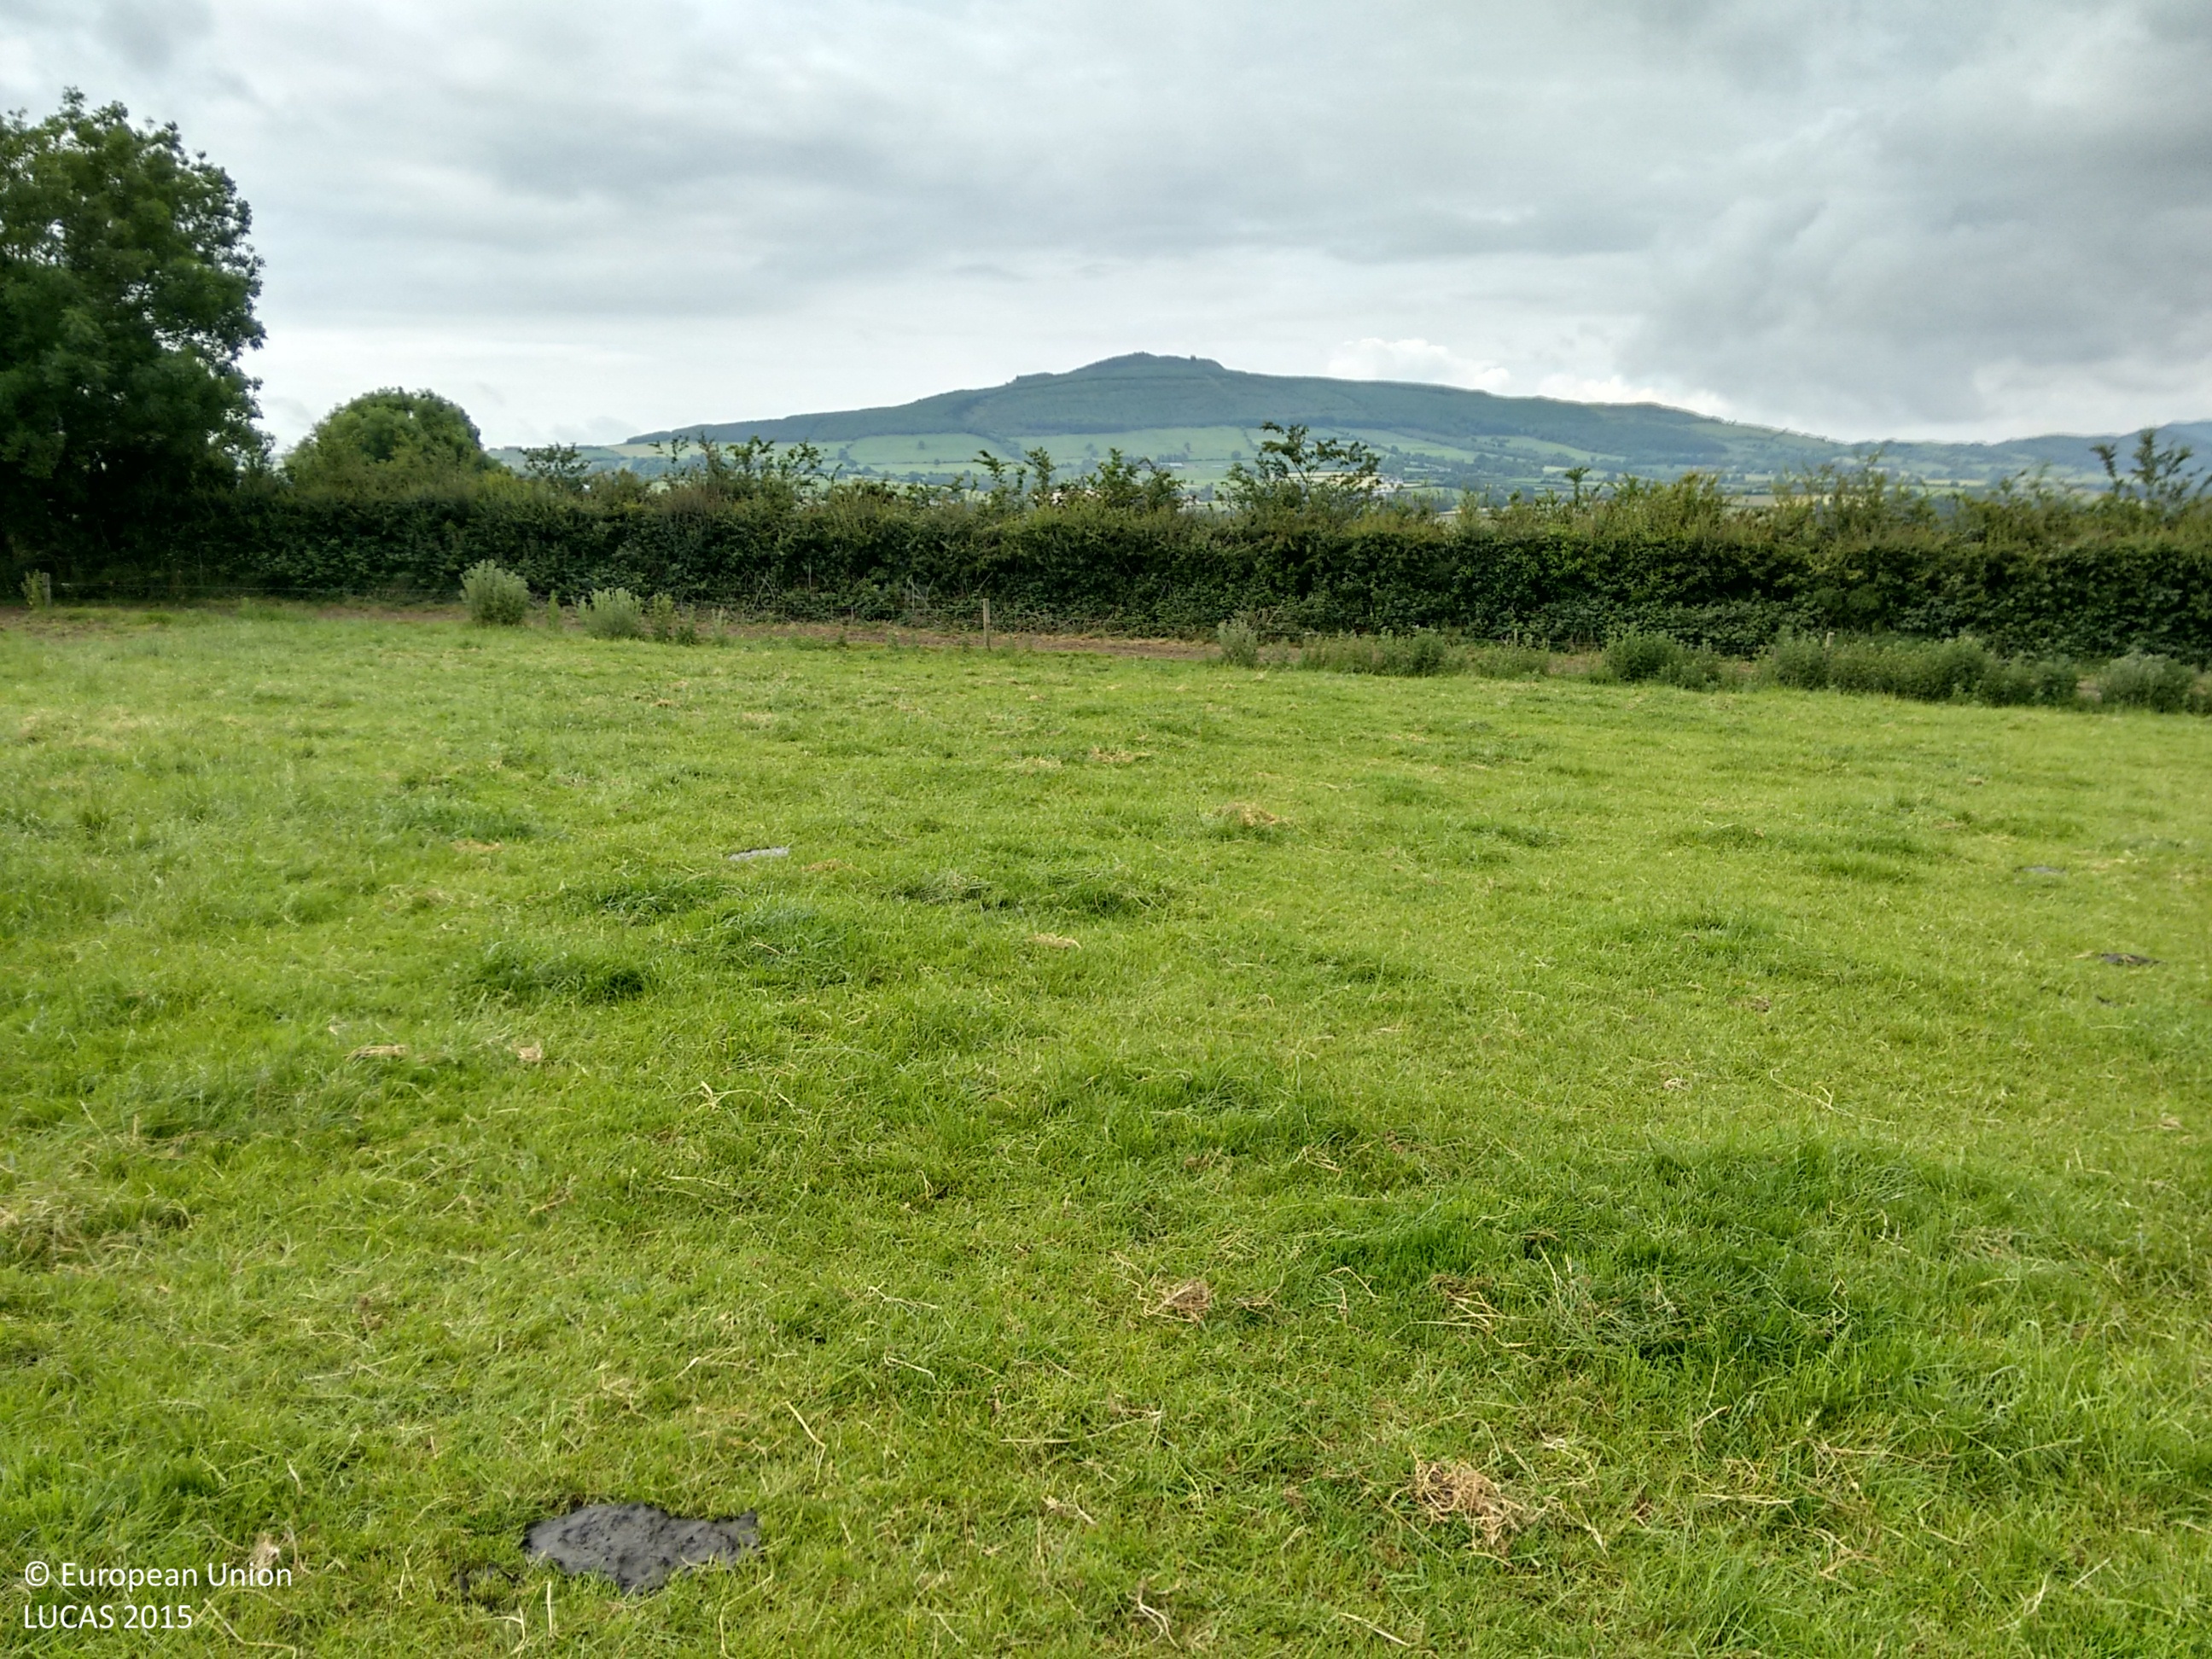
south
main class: Grassland
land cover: Grassland without tree/shrub cover
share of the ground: > 75 %
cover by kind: herbaceous plants 100 %
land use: Agriculture (excluding fallow land and kitchen gardens)
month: June
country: IE
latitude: 52.2872
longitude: -7.4413
